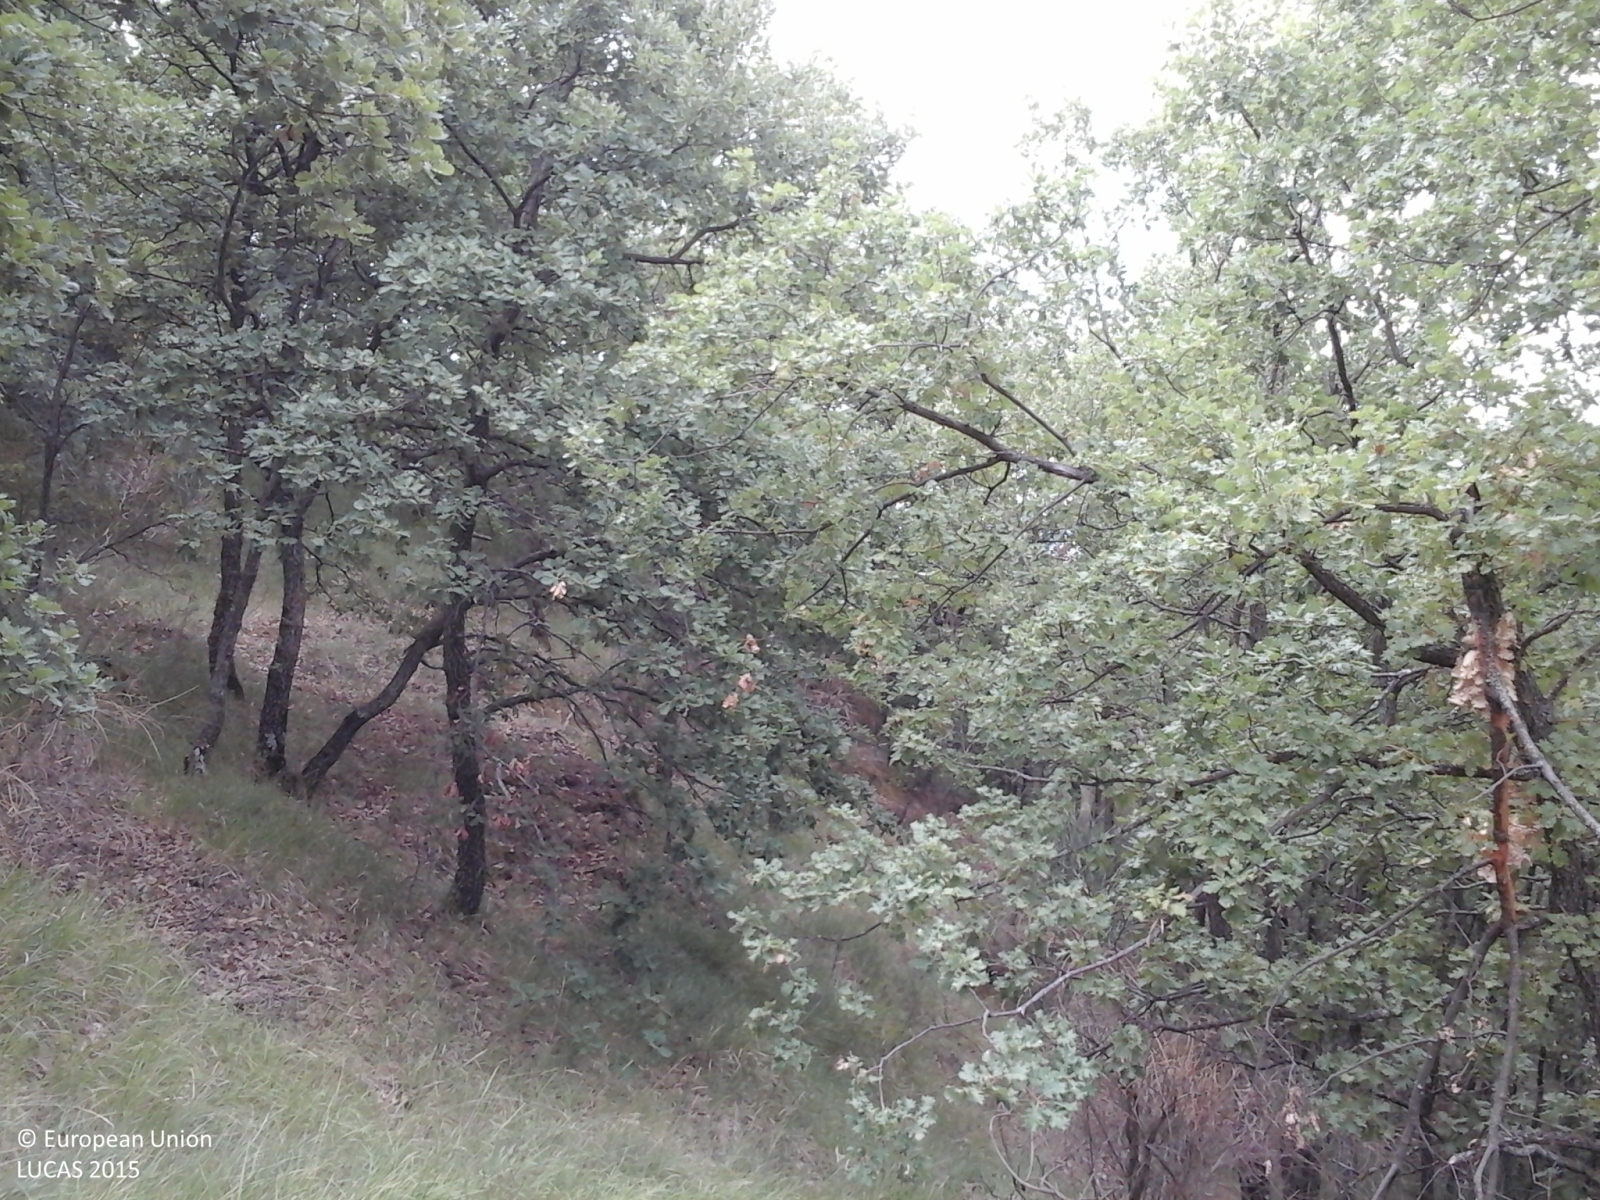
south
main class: Woodland
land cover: Broadleaved woodland
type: thermophilous deciduous forest
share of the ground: > 75 %
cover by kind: broadleaved forest trees 75 %, shrubs 20 %, herbaceous plants 5 %
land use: Semi-natural and natural areas not in use
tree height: > 5 m
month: August
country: IT
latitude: 41.7985
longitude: 14.4019
